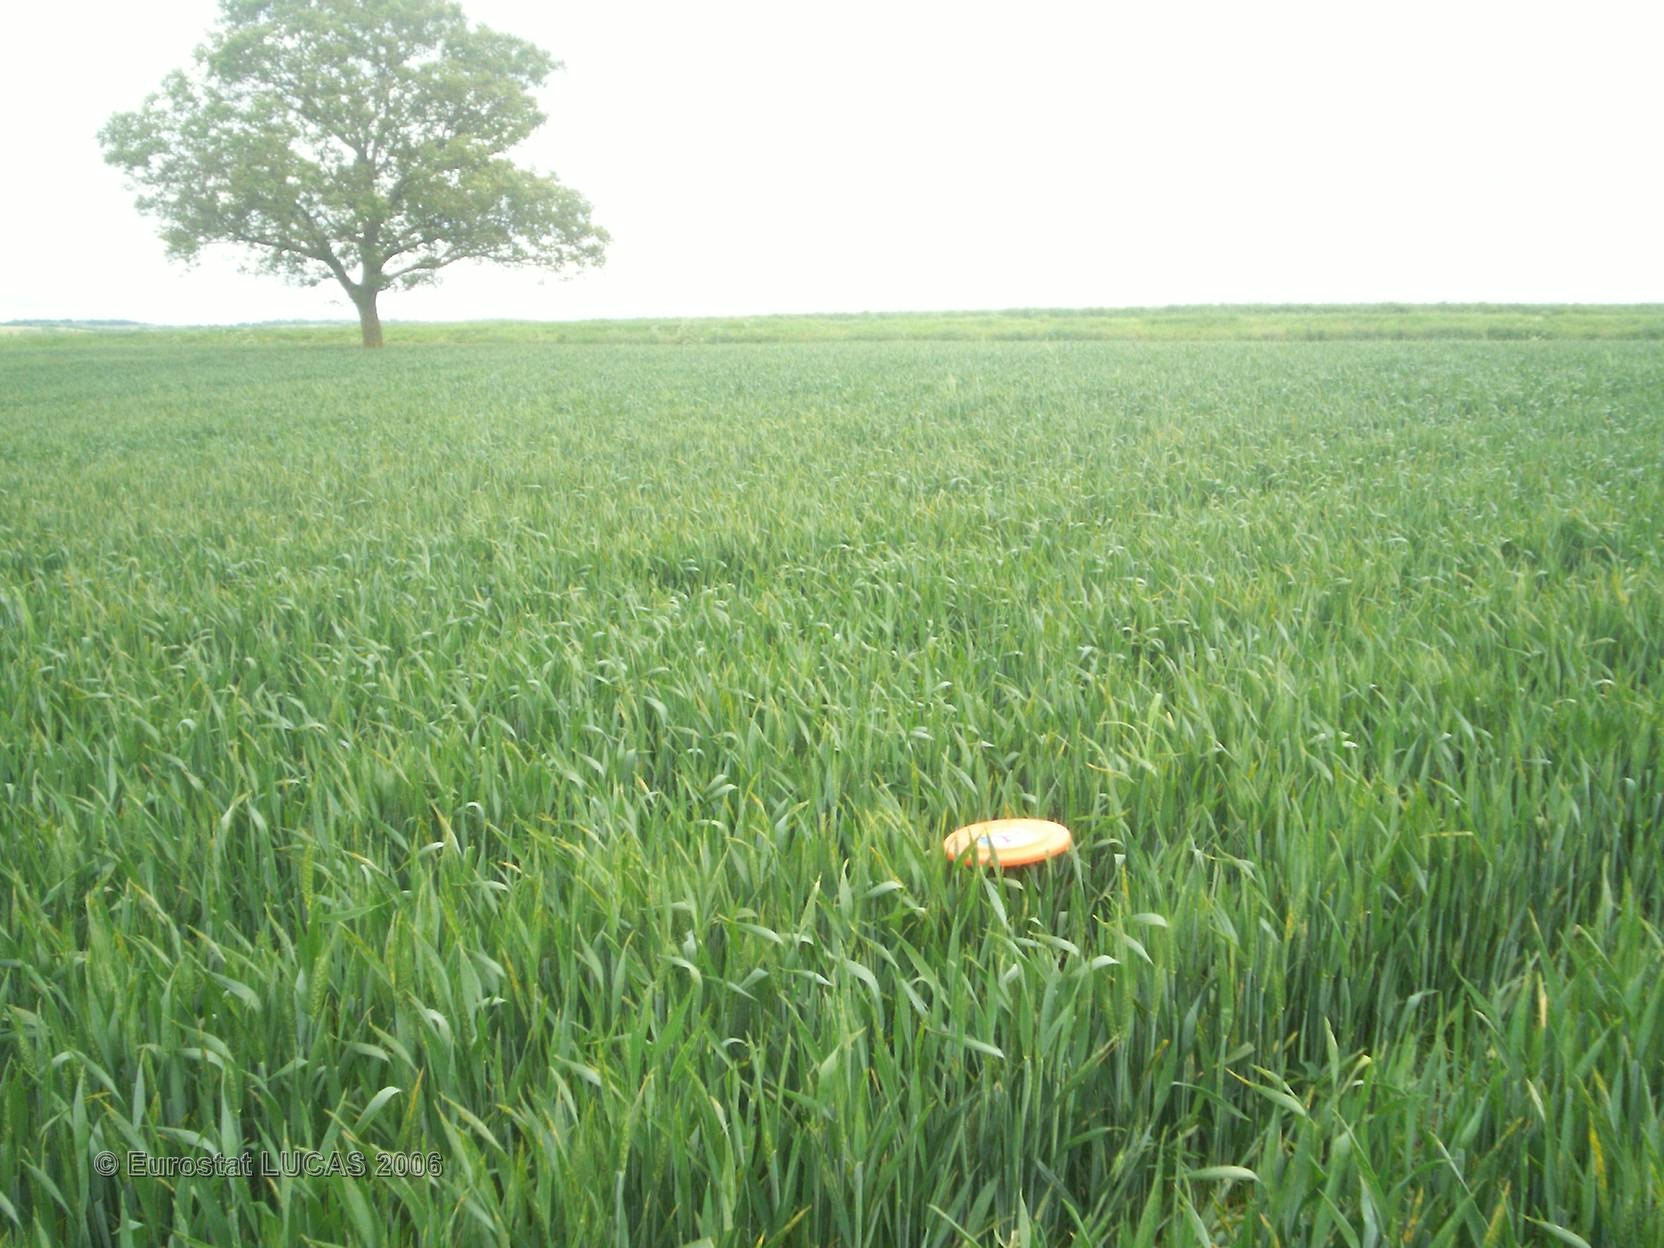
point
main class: Cropland
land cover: Common wheat
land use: Agriculture (excluding fallow land and kitchen gardens)
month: May
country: FR
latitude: 46.1479
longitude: 3.1238
